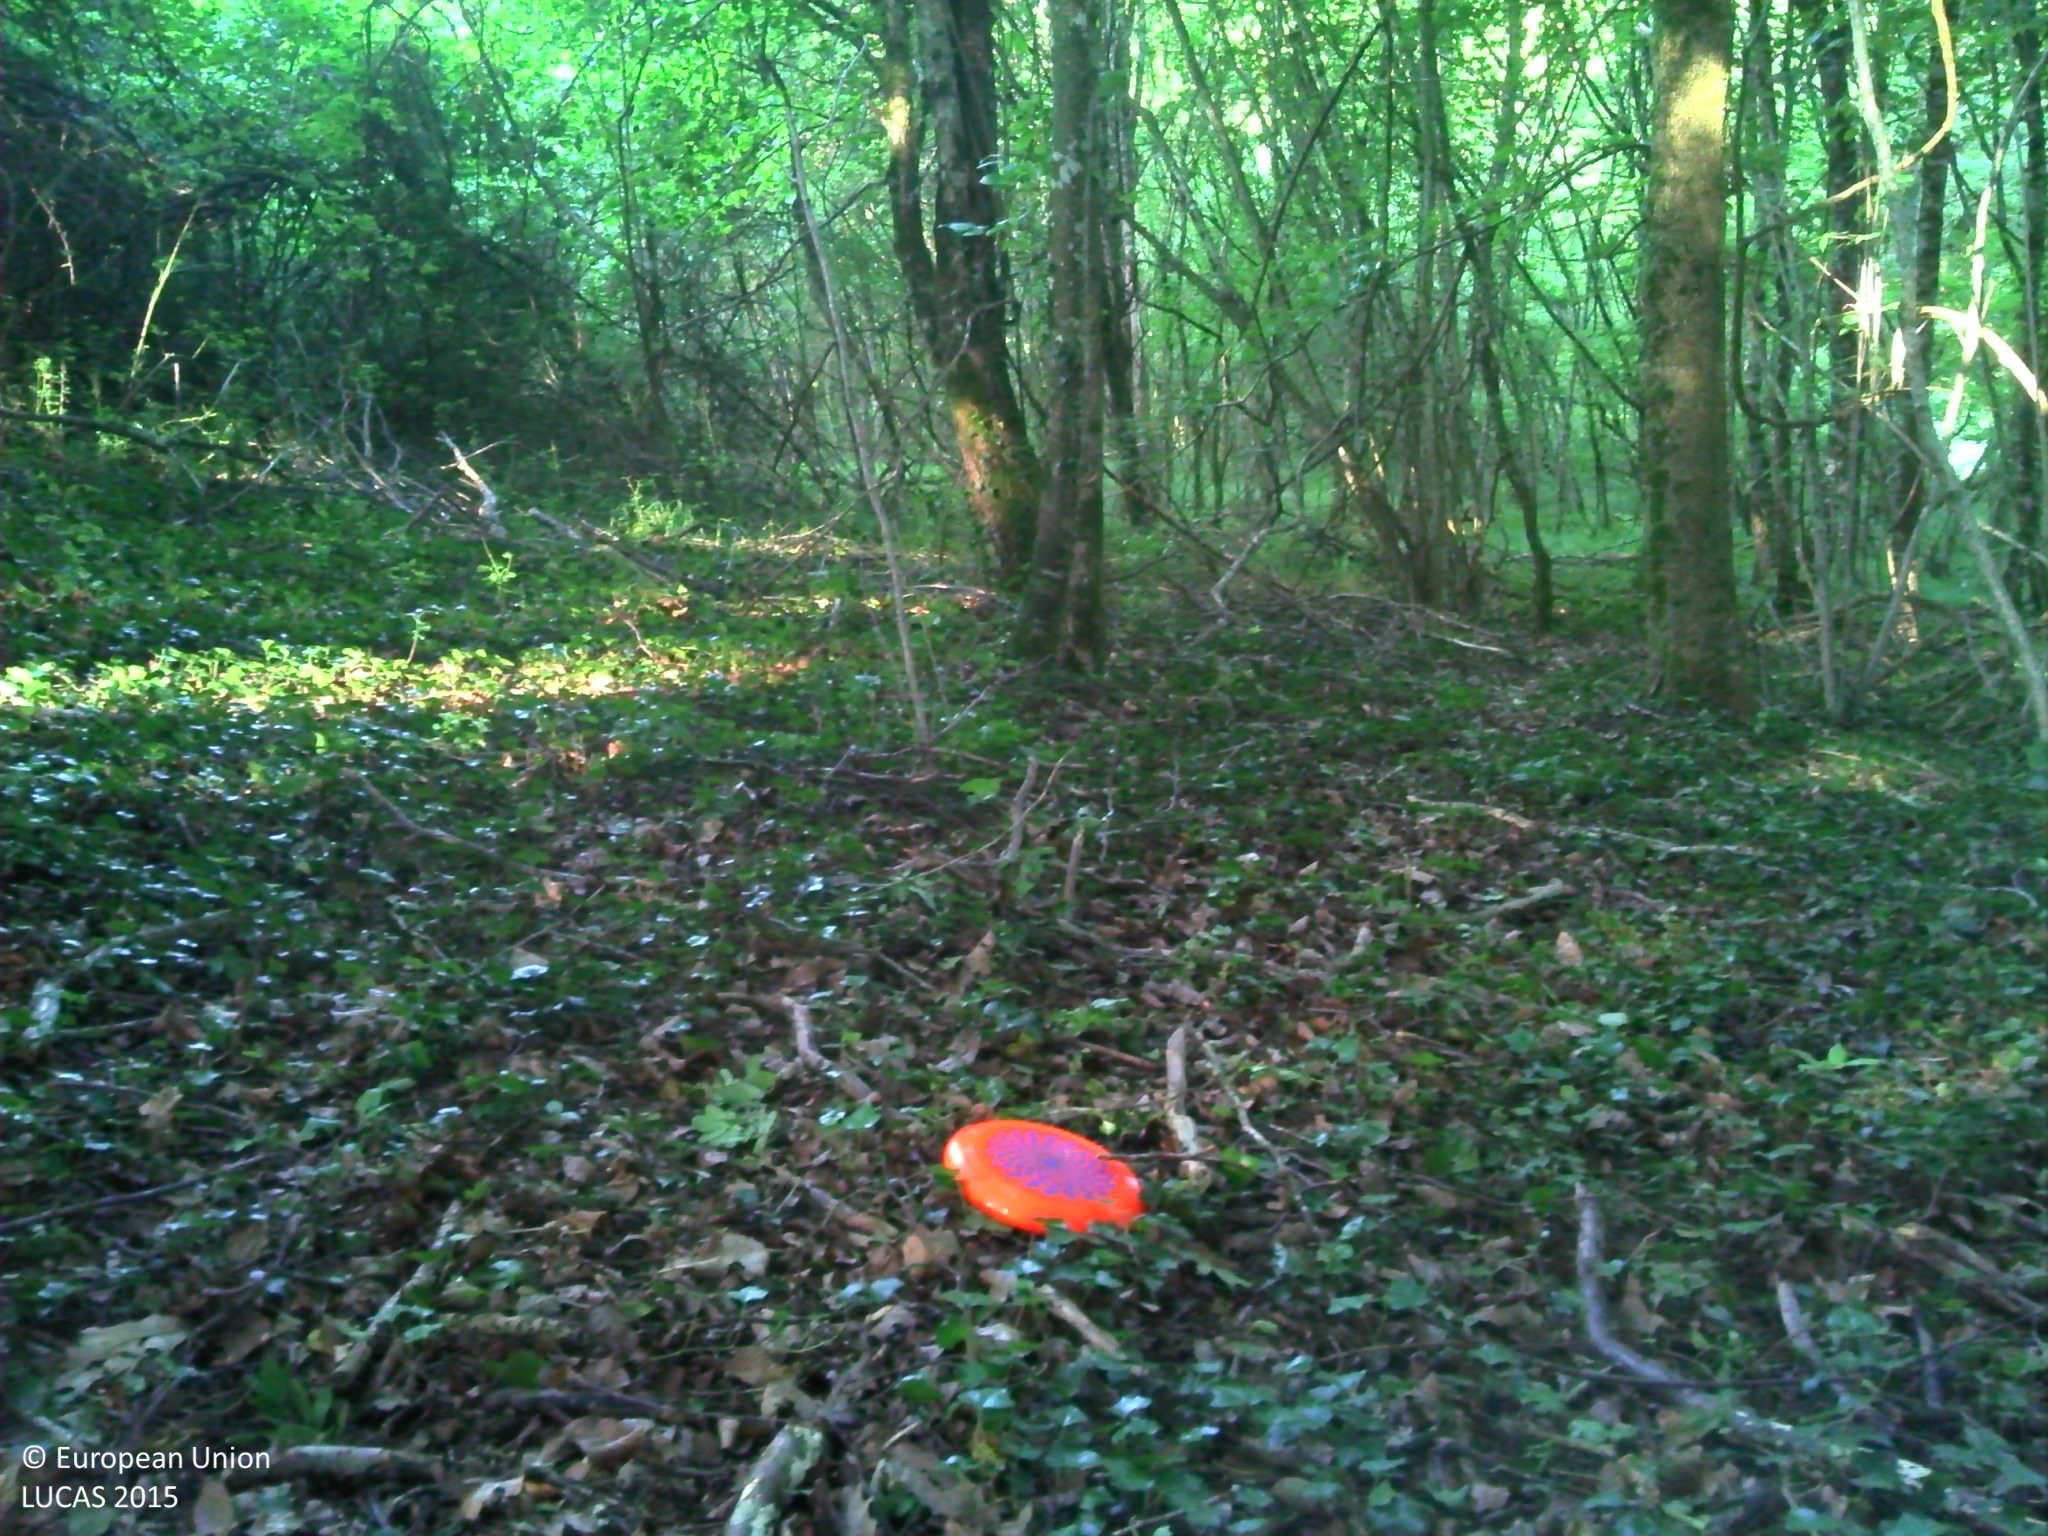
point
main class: Woodland
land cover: Broadleaved woodland
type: mesophytic deciduous forest
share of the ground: > 75 %
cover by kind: broadleaved forest trees 80 %, herbaceous plants 10 %, shrubs 5 %, lichens and mosses 5 %
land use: Forestry
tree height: > 5 m
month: June
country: FR
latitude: 47.2364
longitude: 3.1929
